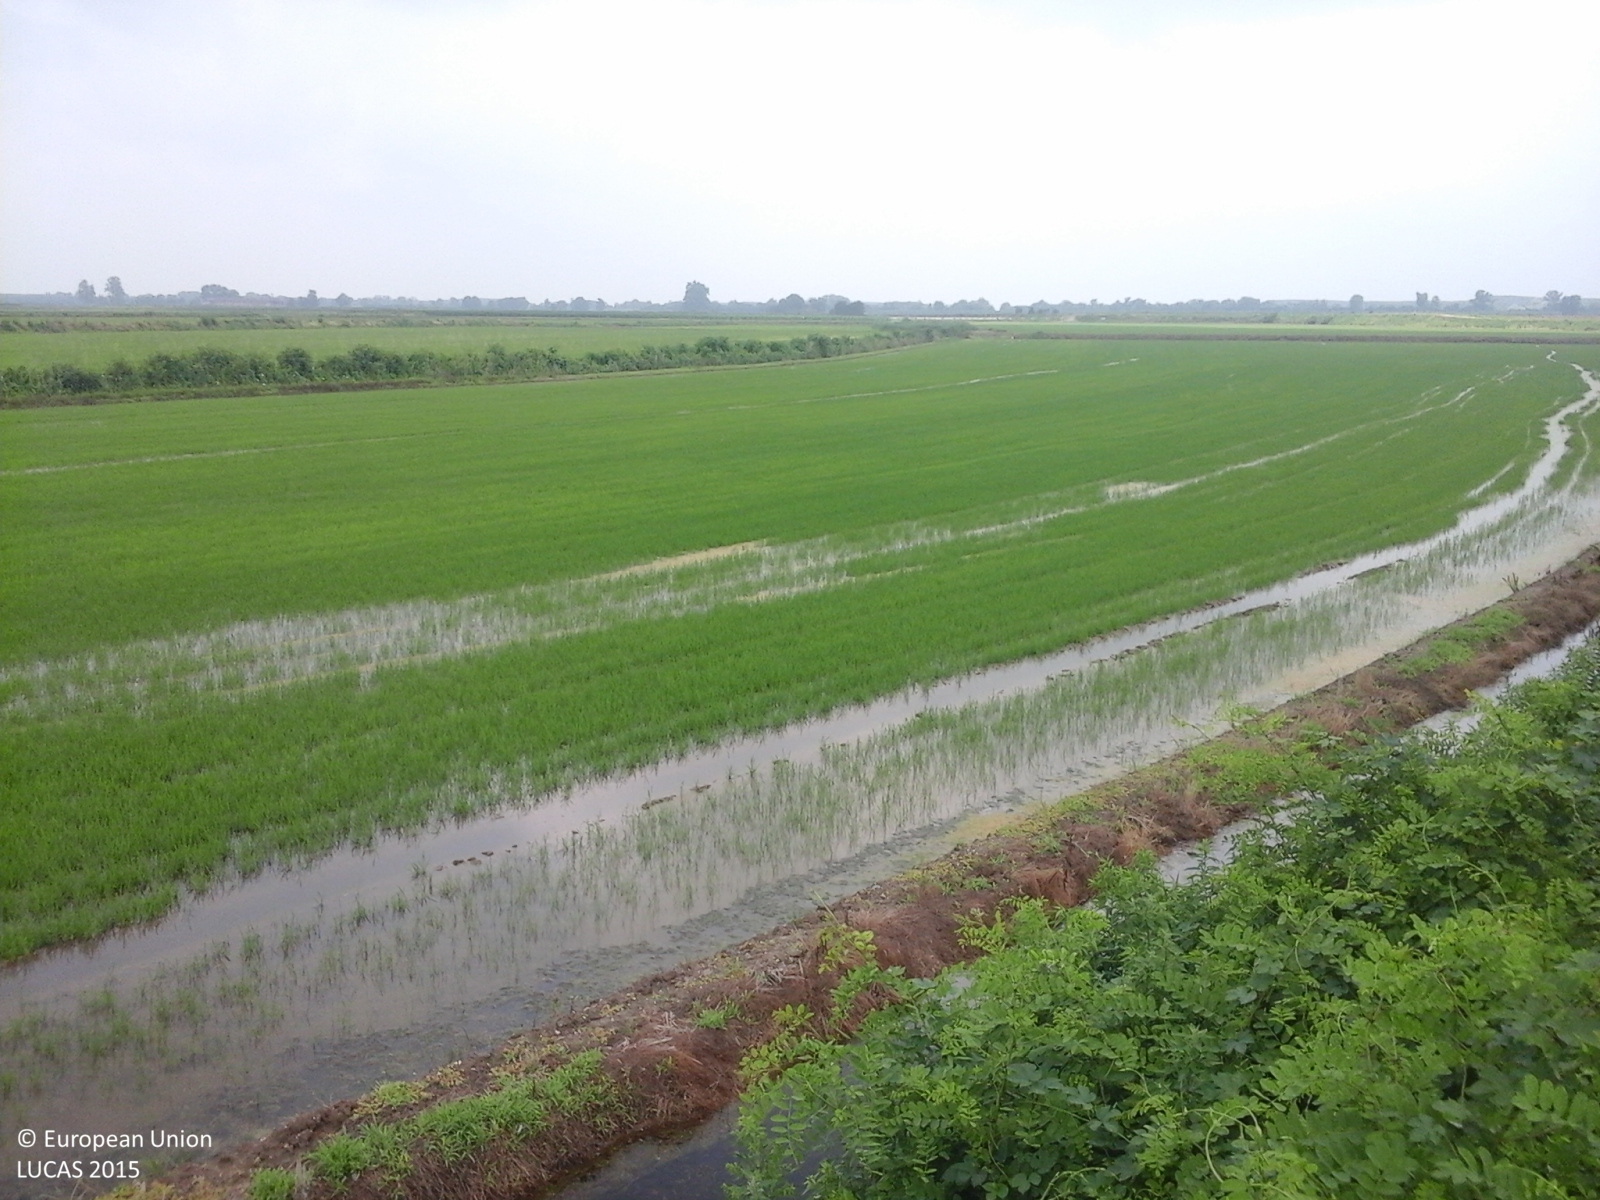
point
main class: Cropland
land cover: Rice
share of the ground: > 75 %
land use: Agriculture (excluding fallow land and kitchen gardens)
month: June
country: IT
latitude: 45.2242
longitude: 8.5634
